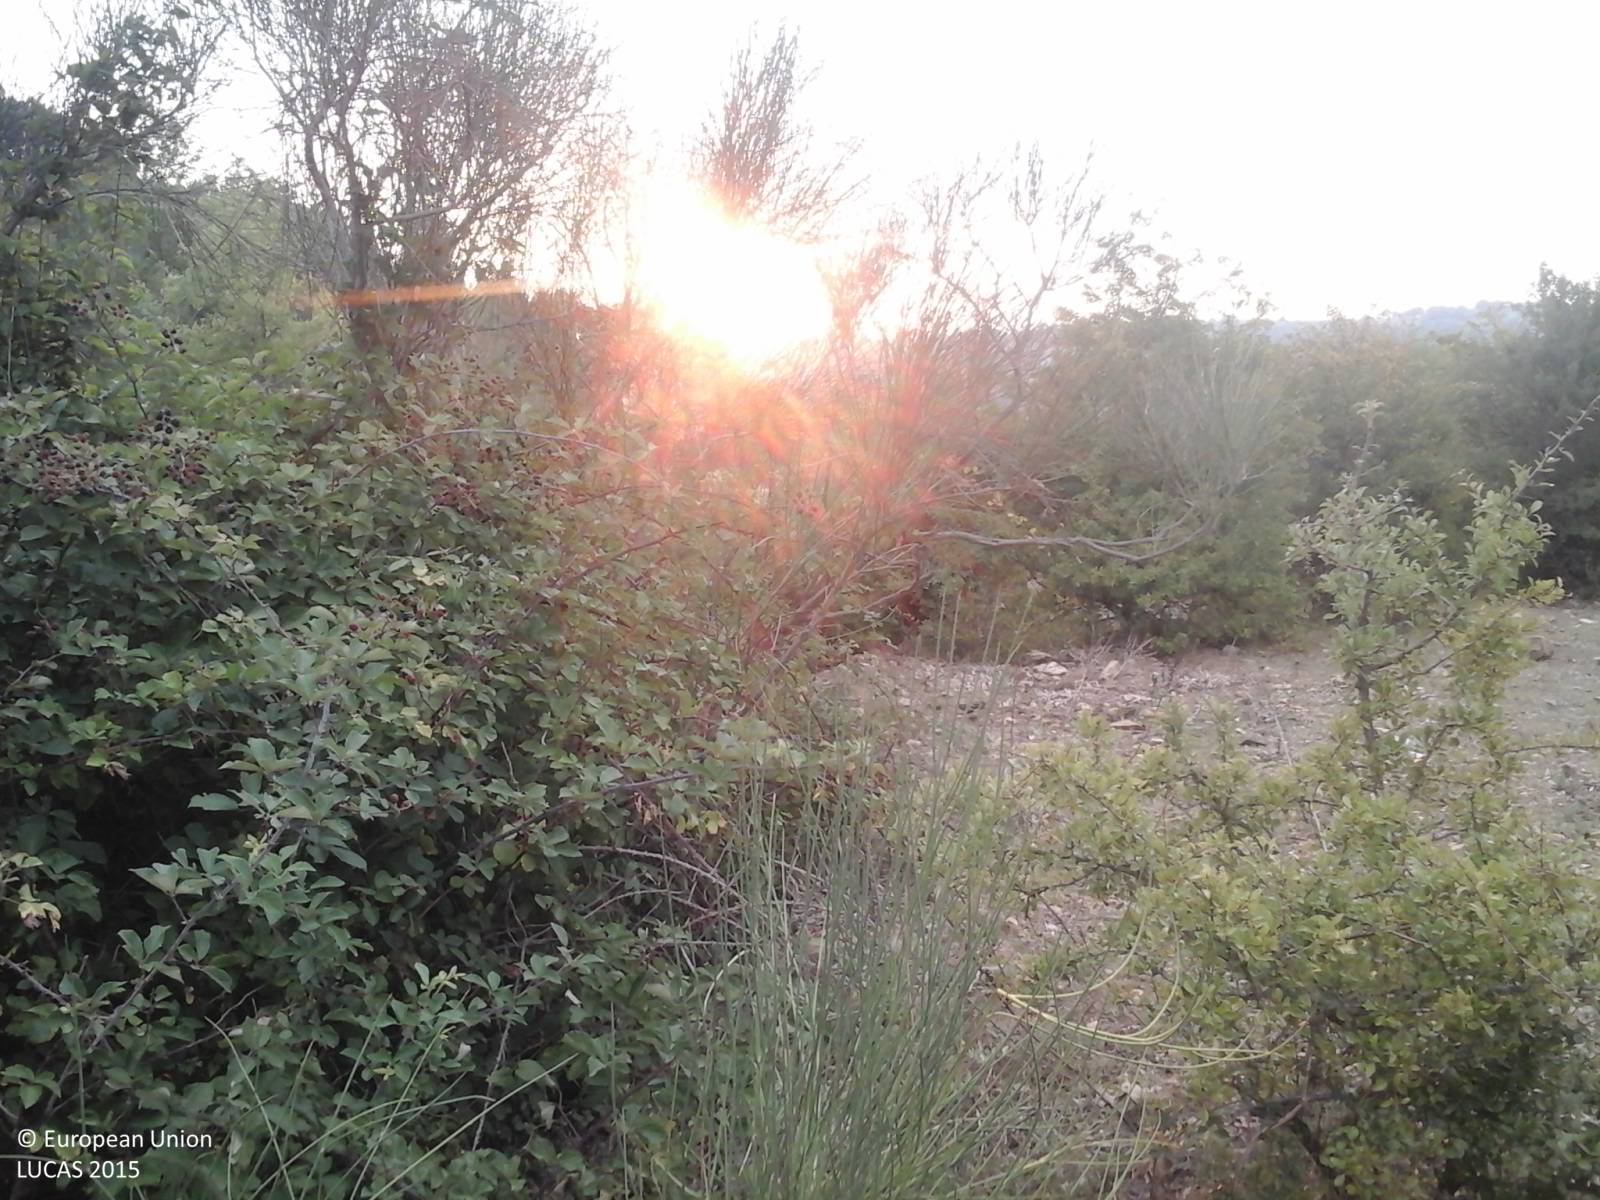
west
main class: Woodland
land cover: Broadleaved woodland
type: thermophilous deciduous forest
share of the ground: > 75 %
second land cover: Grassland without tree/shrub cover
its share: 25 - 50 %
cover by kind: broadleaved forest trees 65 %, shrubs 25 %, herbaceous plants 10 %
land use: Forestry
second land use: Agriculture (excluding fallow land and kitchen gardens)
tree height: < 5 m
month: August
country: IT
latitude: 42.2360
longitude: 12.0406
